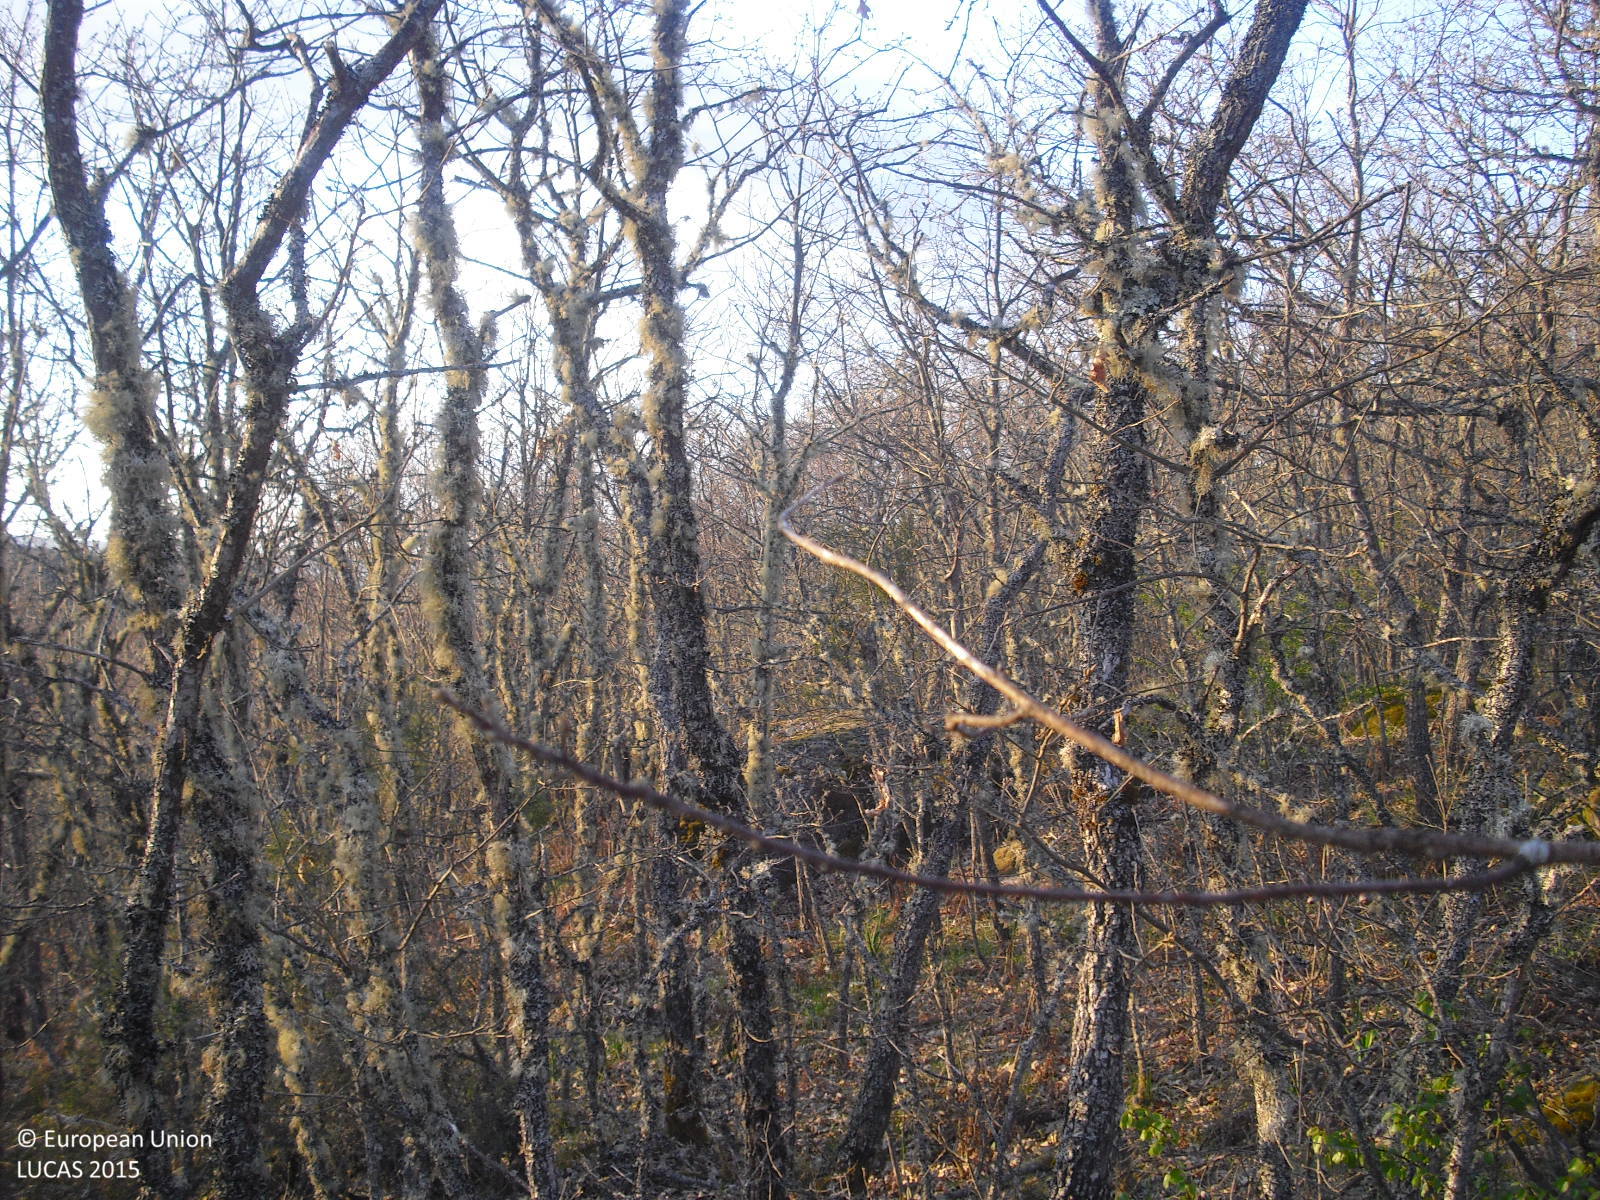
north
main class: Woodland
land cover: Broadleaved woodland
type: thermophilous deciduous forest
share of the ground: > 75 %
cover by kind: broadleaved forest trees 80 %, shrubs 10 %, herbaceous plants 5 %, consolidated bare surface 5 %
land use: Forestry
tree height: > 5 m
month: April
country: ES
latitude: 41.9628
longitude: -7.8194
